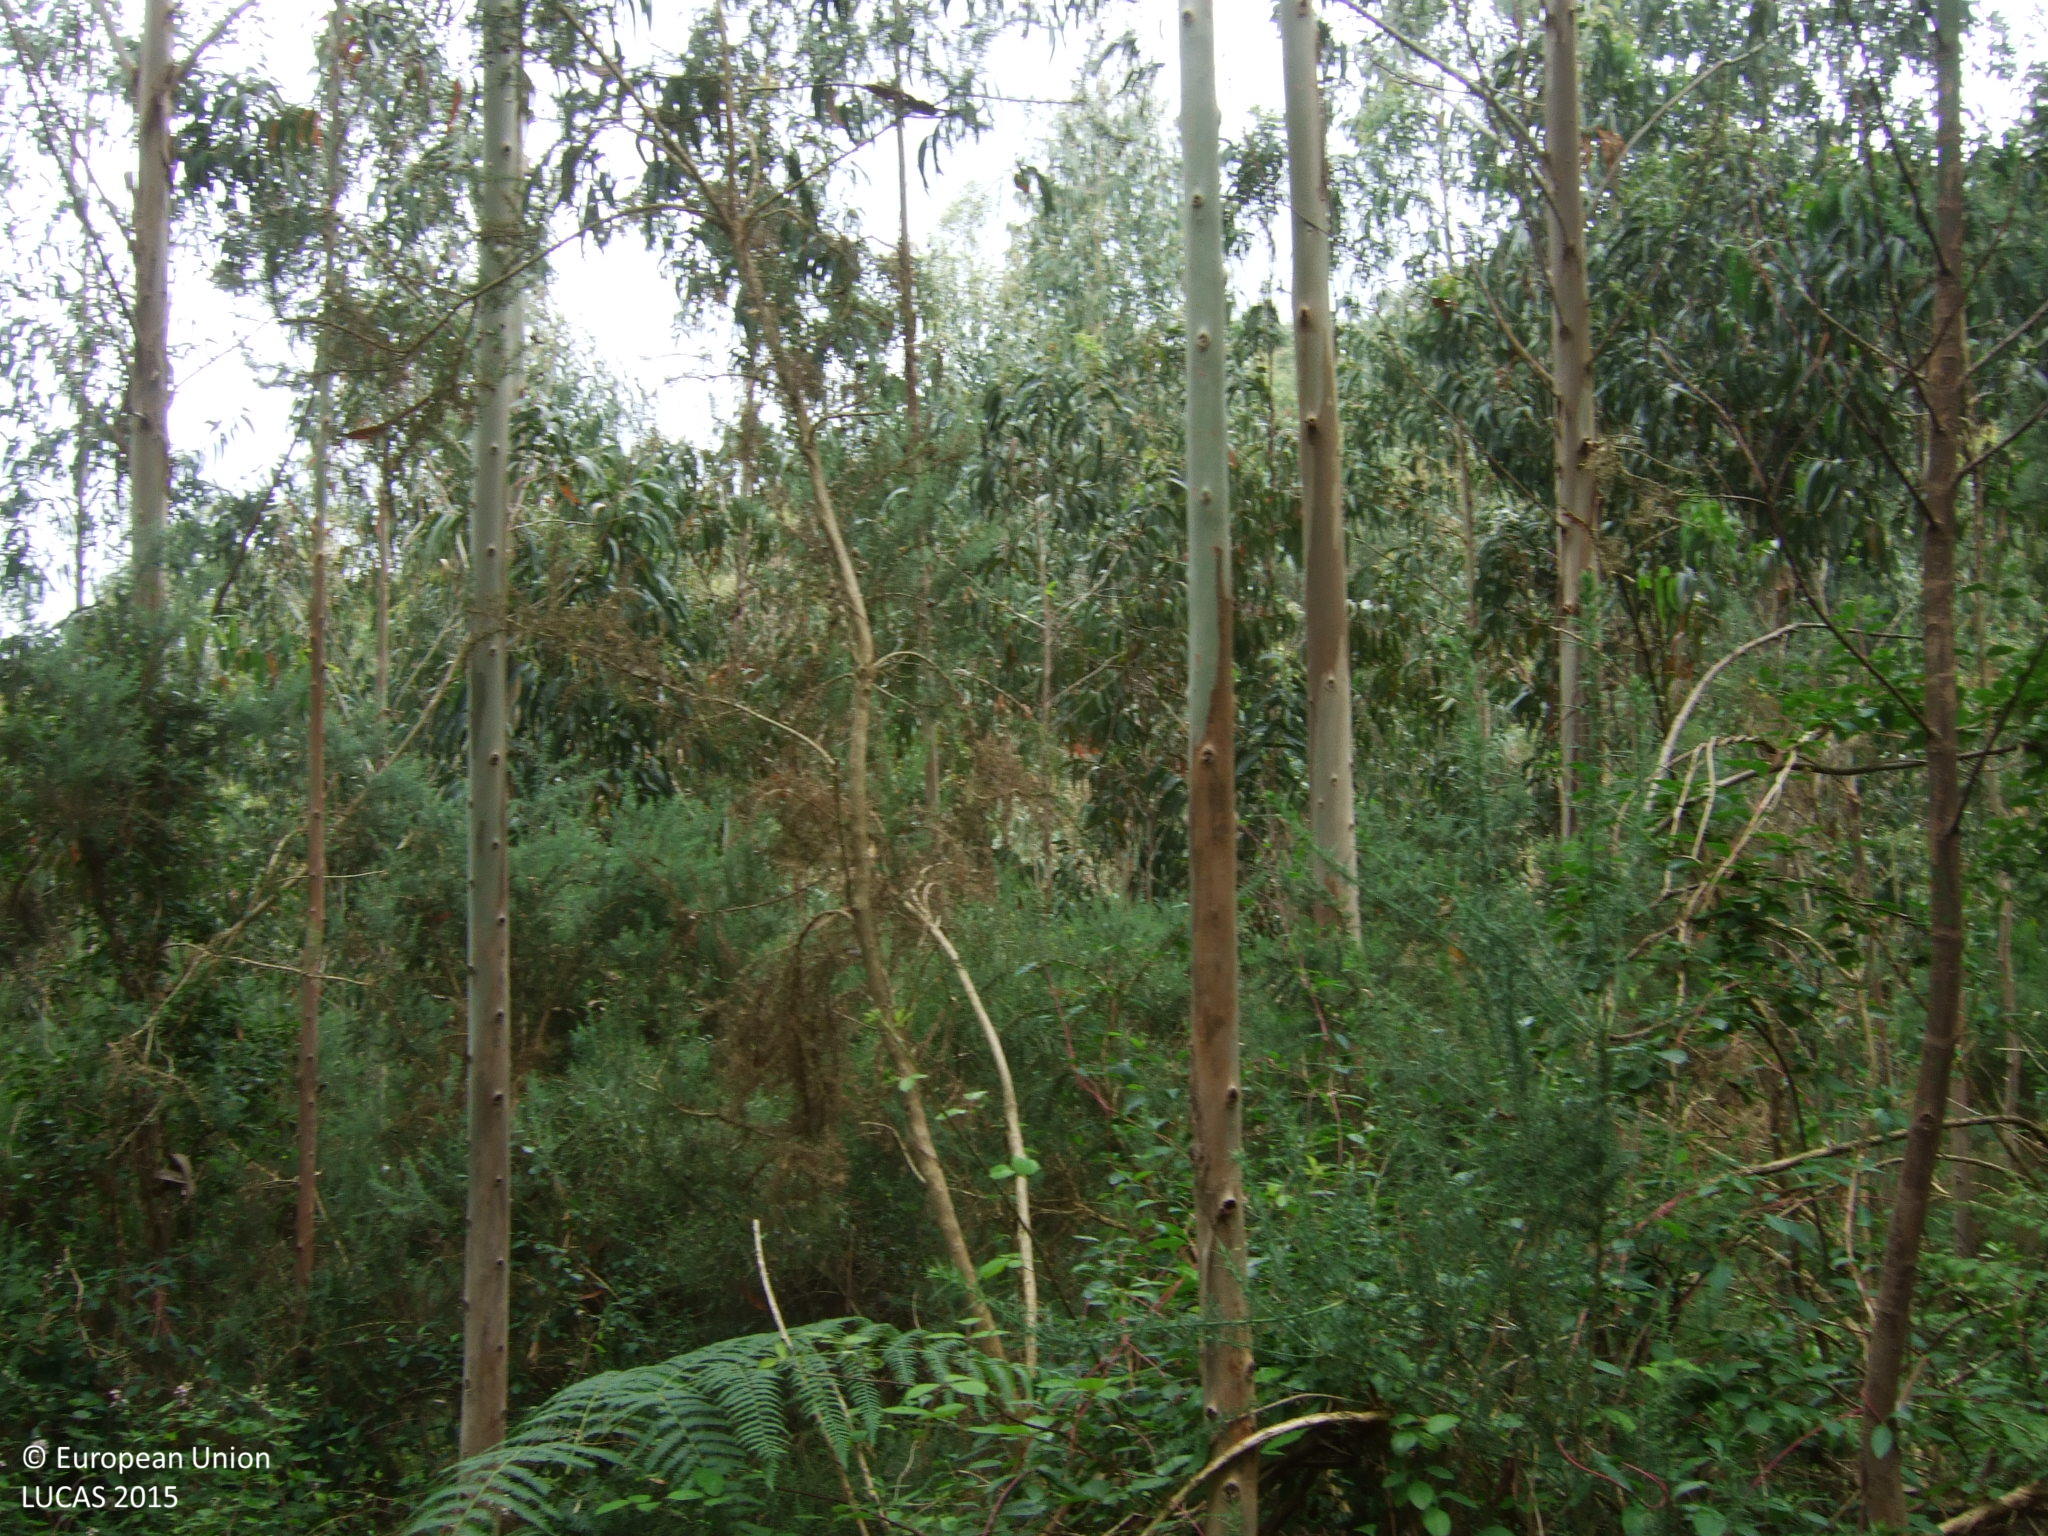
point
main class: Woodland
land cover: Broadleaved woodland
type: exotic forest
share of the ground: 50 - 75 %
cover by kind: broadleaved forest trees 65 %, shrubs 35 %
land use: Forestry
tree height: > 5 m
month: June
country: ES
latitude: 43.6463
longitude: -7.5783
